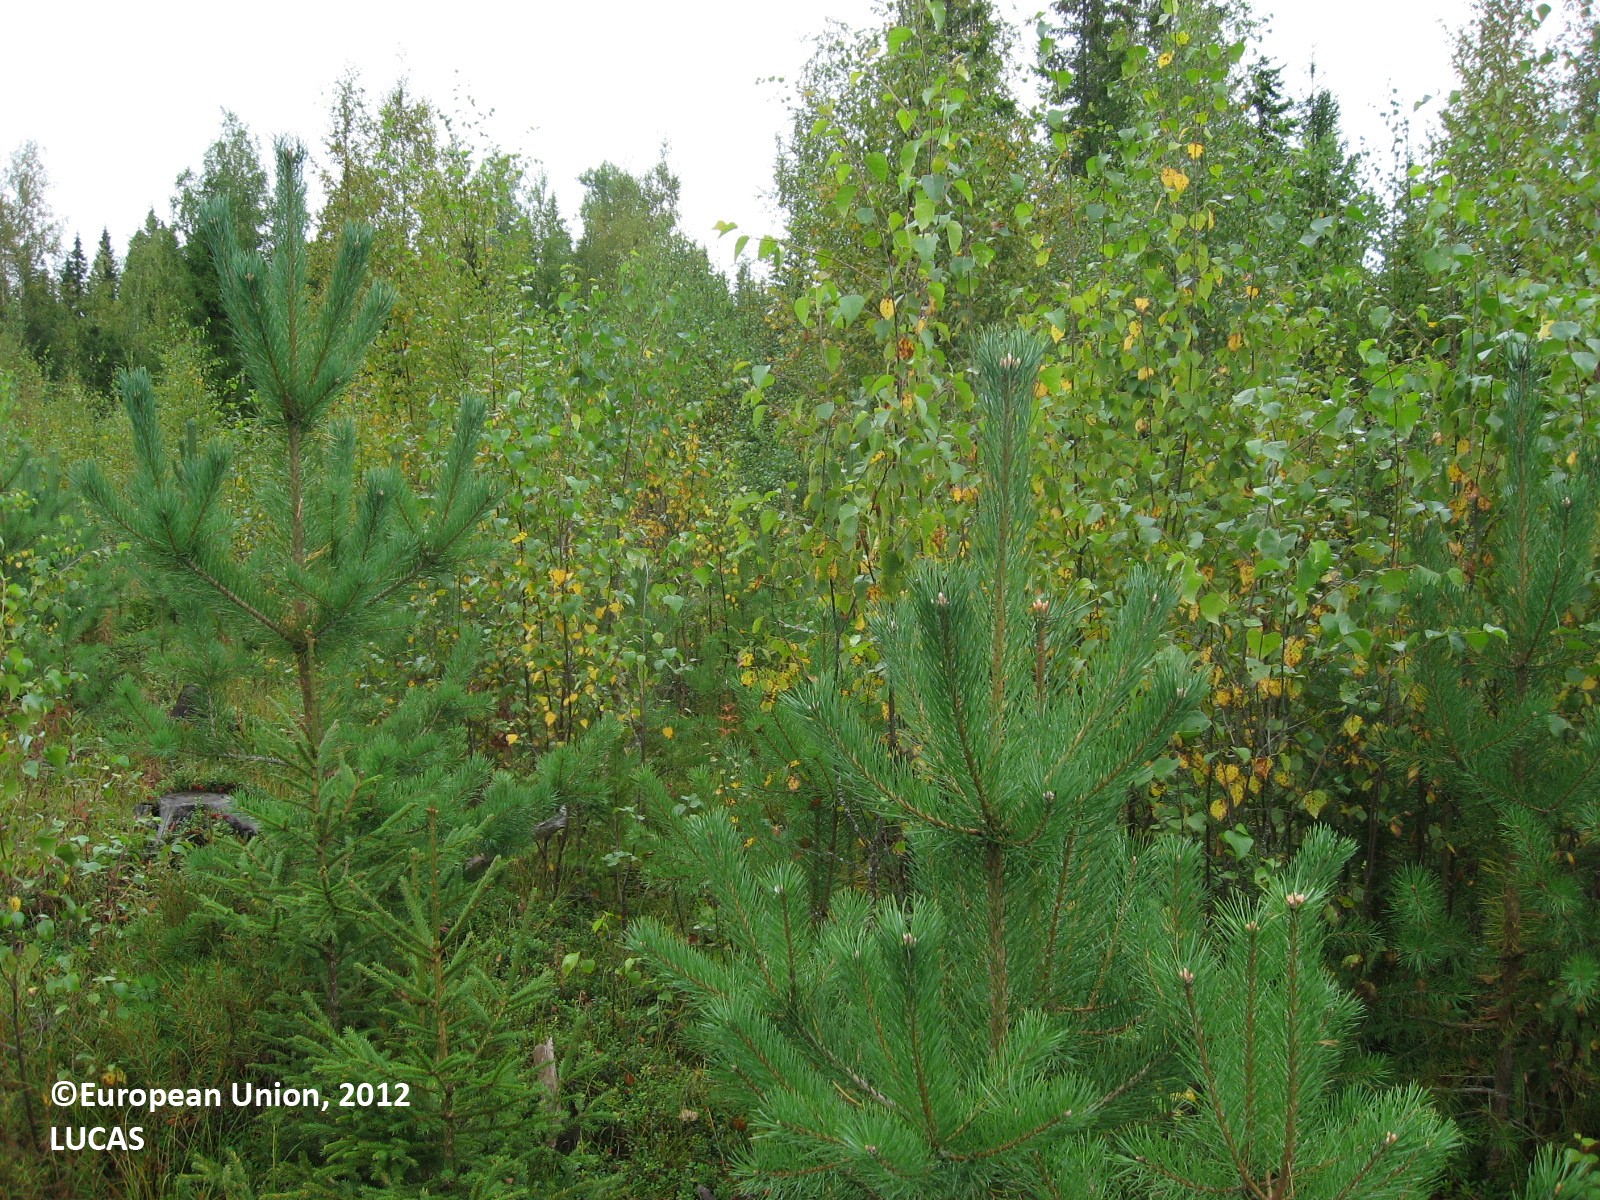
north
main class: Woodland
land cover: Pine dominated mixed woodland
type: boreal forest
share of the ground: 50 - 75 %
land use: Forestry
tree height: < 5 m
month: August
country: FI
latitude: 61.4877
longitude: 24.8095
